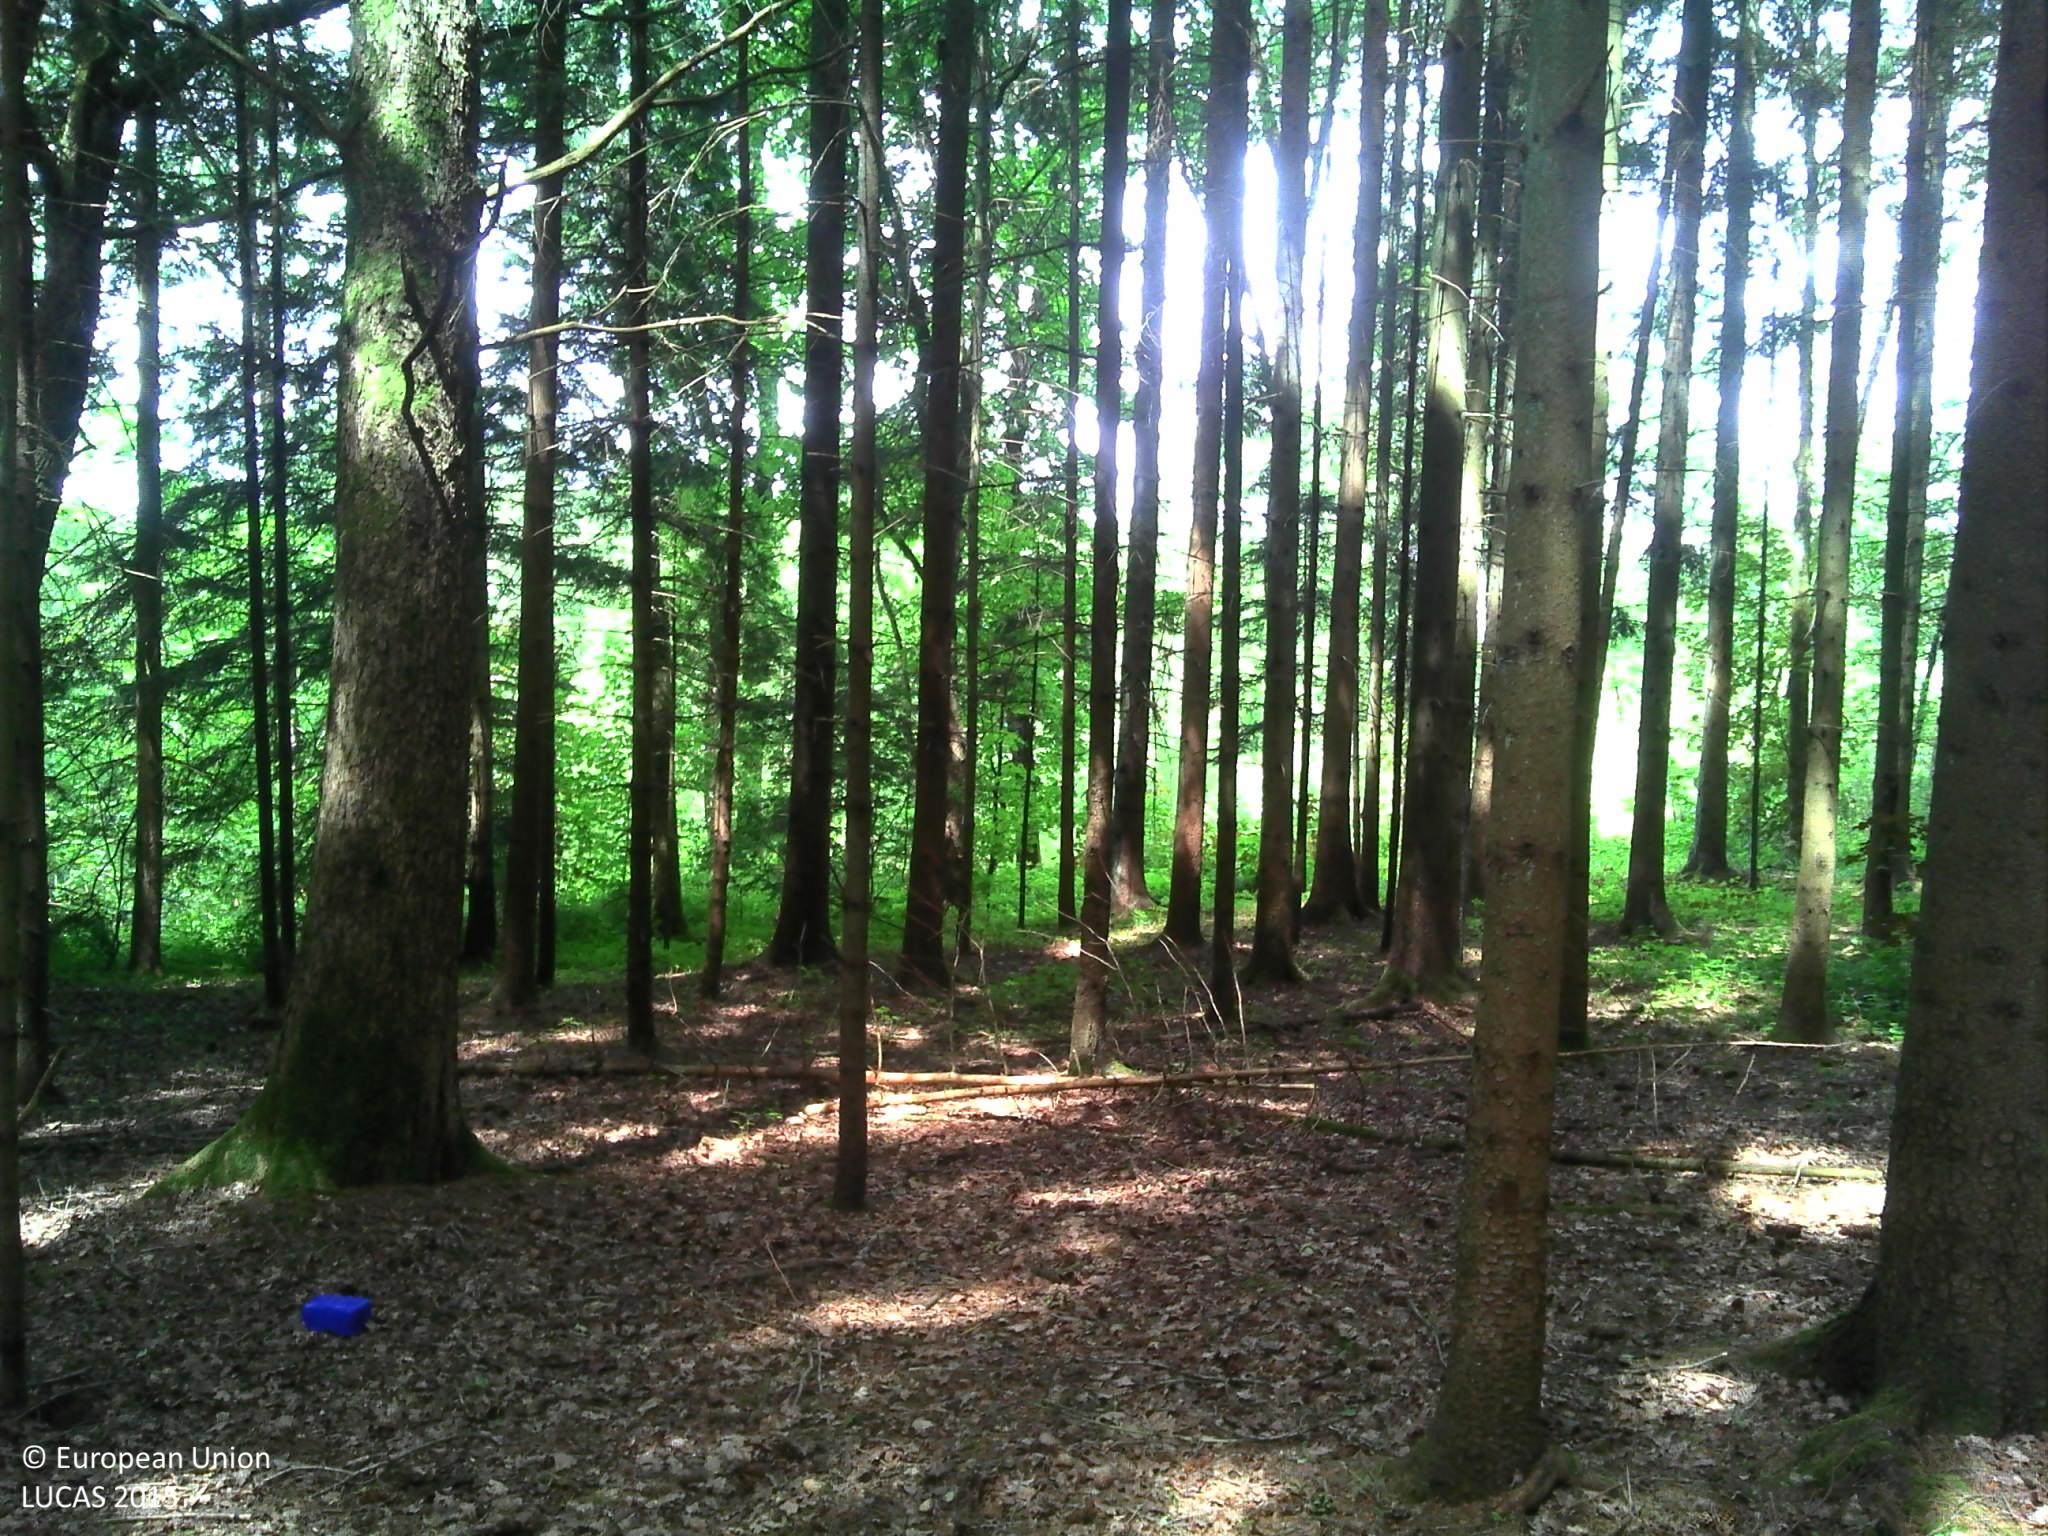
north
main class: Woodland
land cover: Spruce dominated coniferous woodland
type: exotic forest
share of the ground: > 75 %
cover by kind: coniferous forest trees 95 %, broadleaved forest trees 5 %
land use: Forestry
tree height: > 5 m
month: June
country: BE
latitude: 50.3291
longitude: 5.4890
